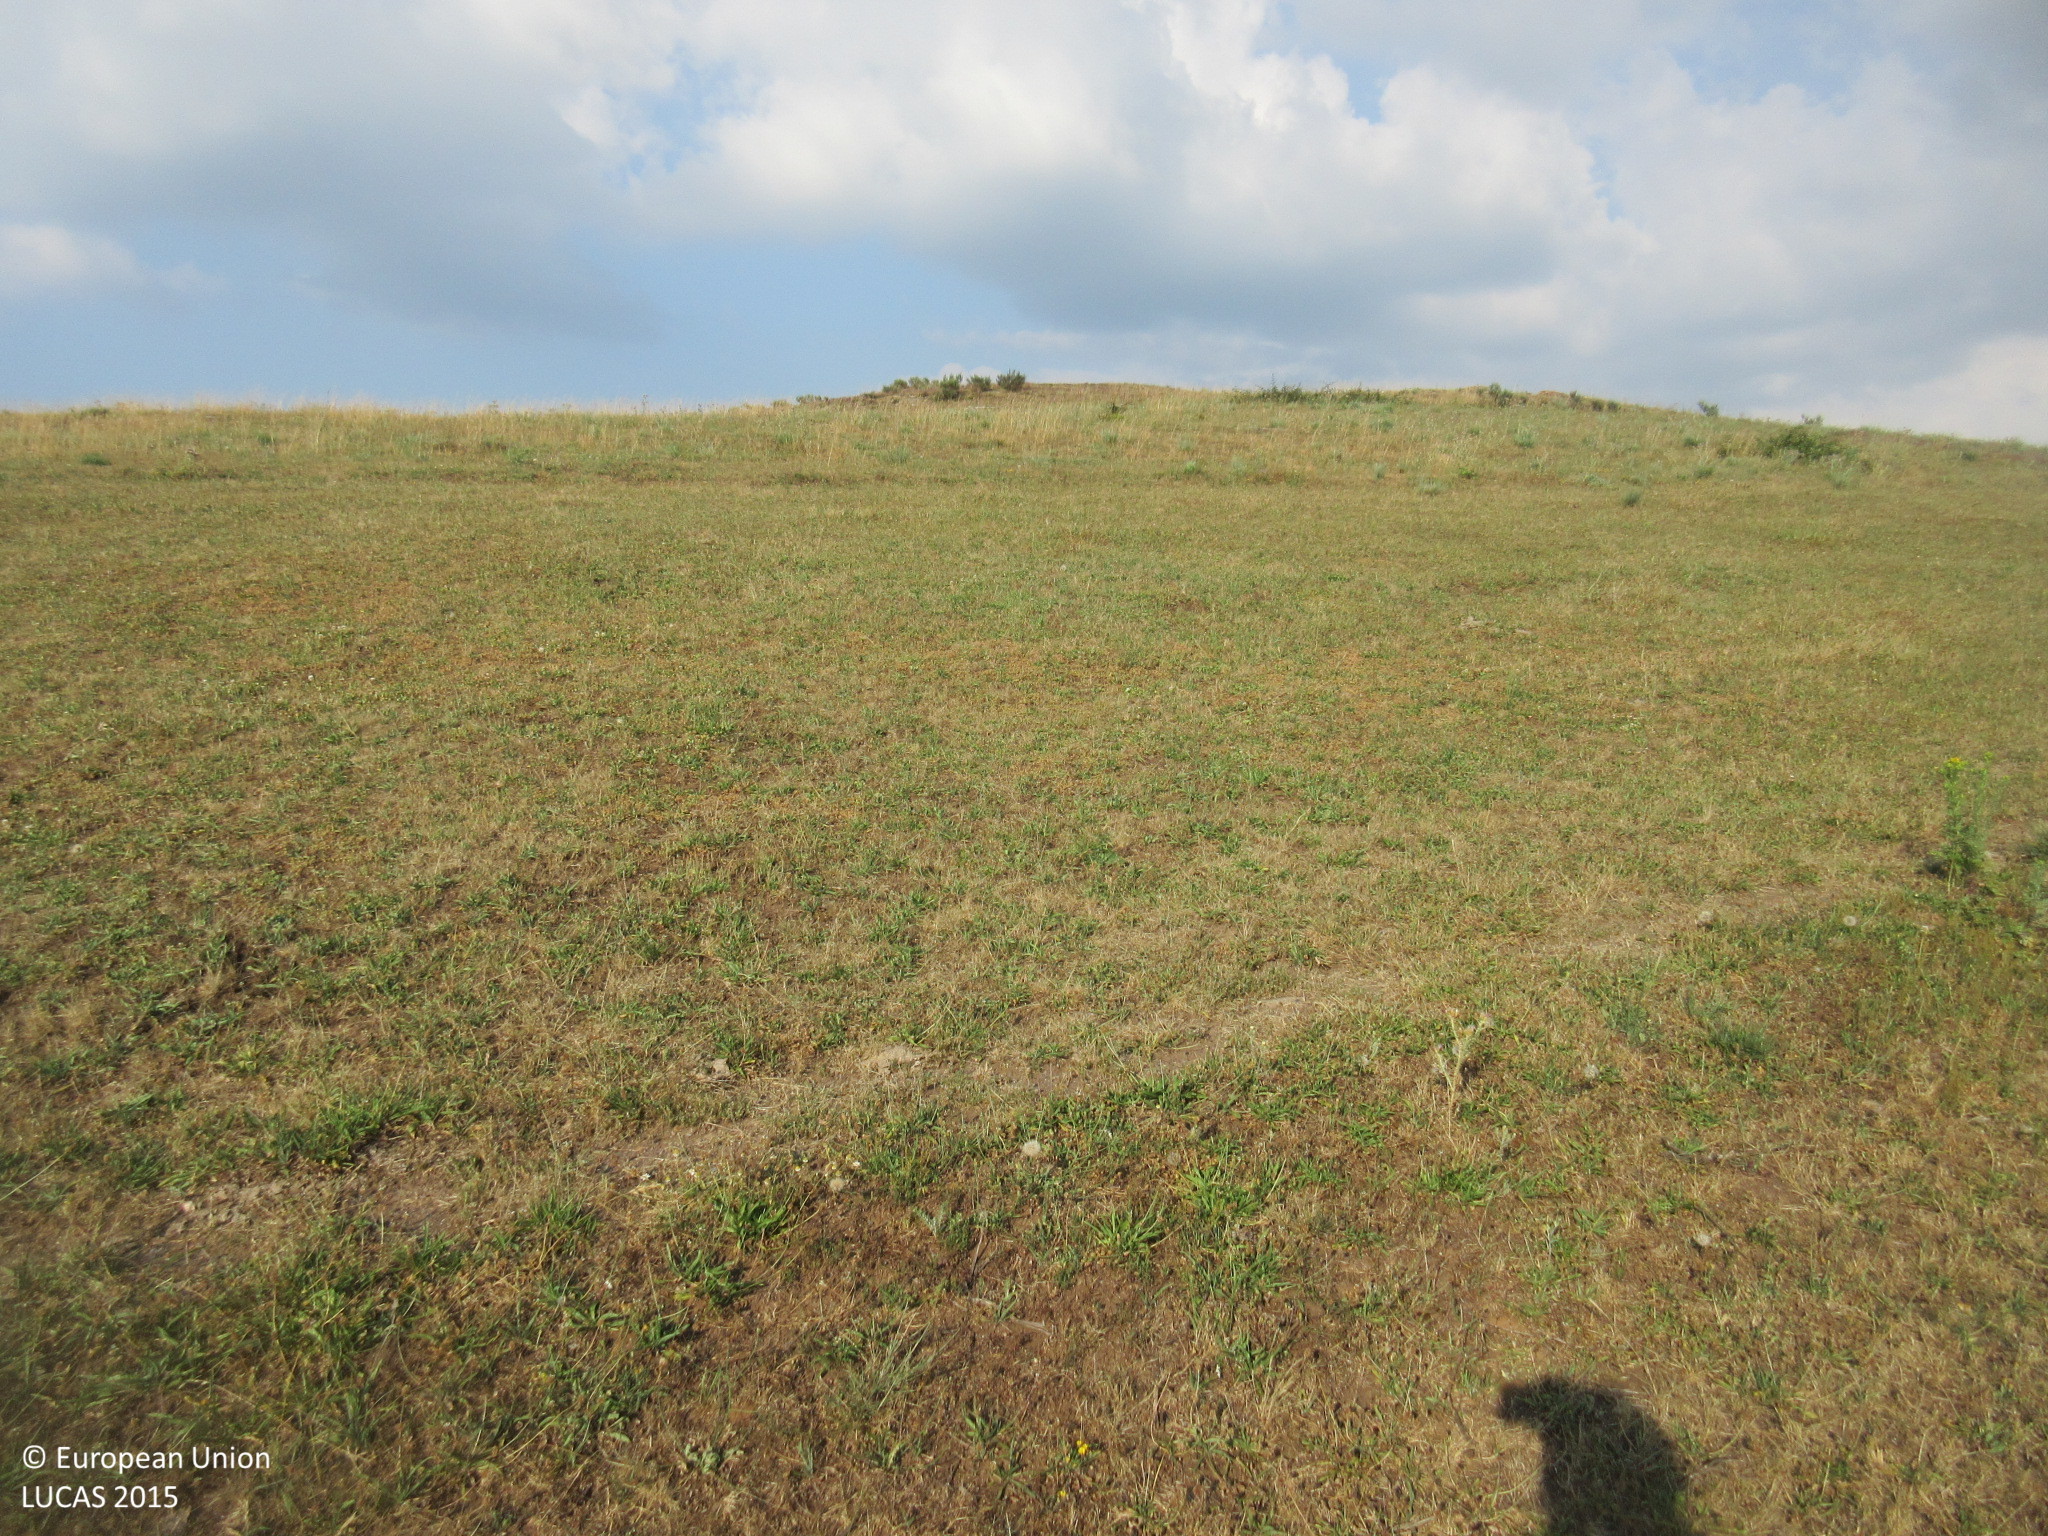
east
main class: Grassland
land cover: Grassland without tree/shrub cover
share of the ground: > 75 %
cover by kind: herbaceous plants 100 %
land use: Agriculture (excluding fallow land and kitchen gardens)
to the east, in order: Grassland without tree/shrub cover; Shrubland without tree cover; Grassland without tree/shrub cover; Shrubland without tree cover; Grassland without tree/shrub cover; Broadleaved woodland
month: June
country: ES
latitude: 42.9297
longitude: -7.0322
